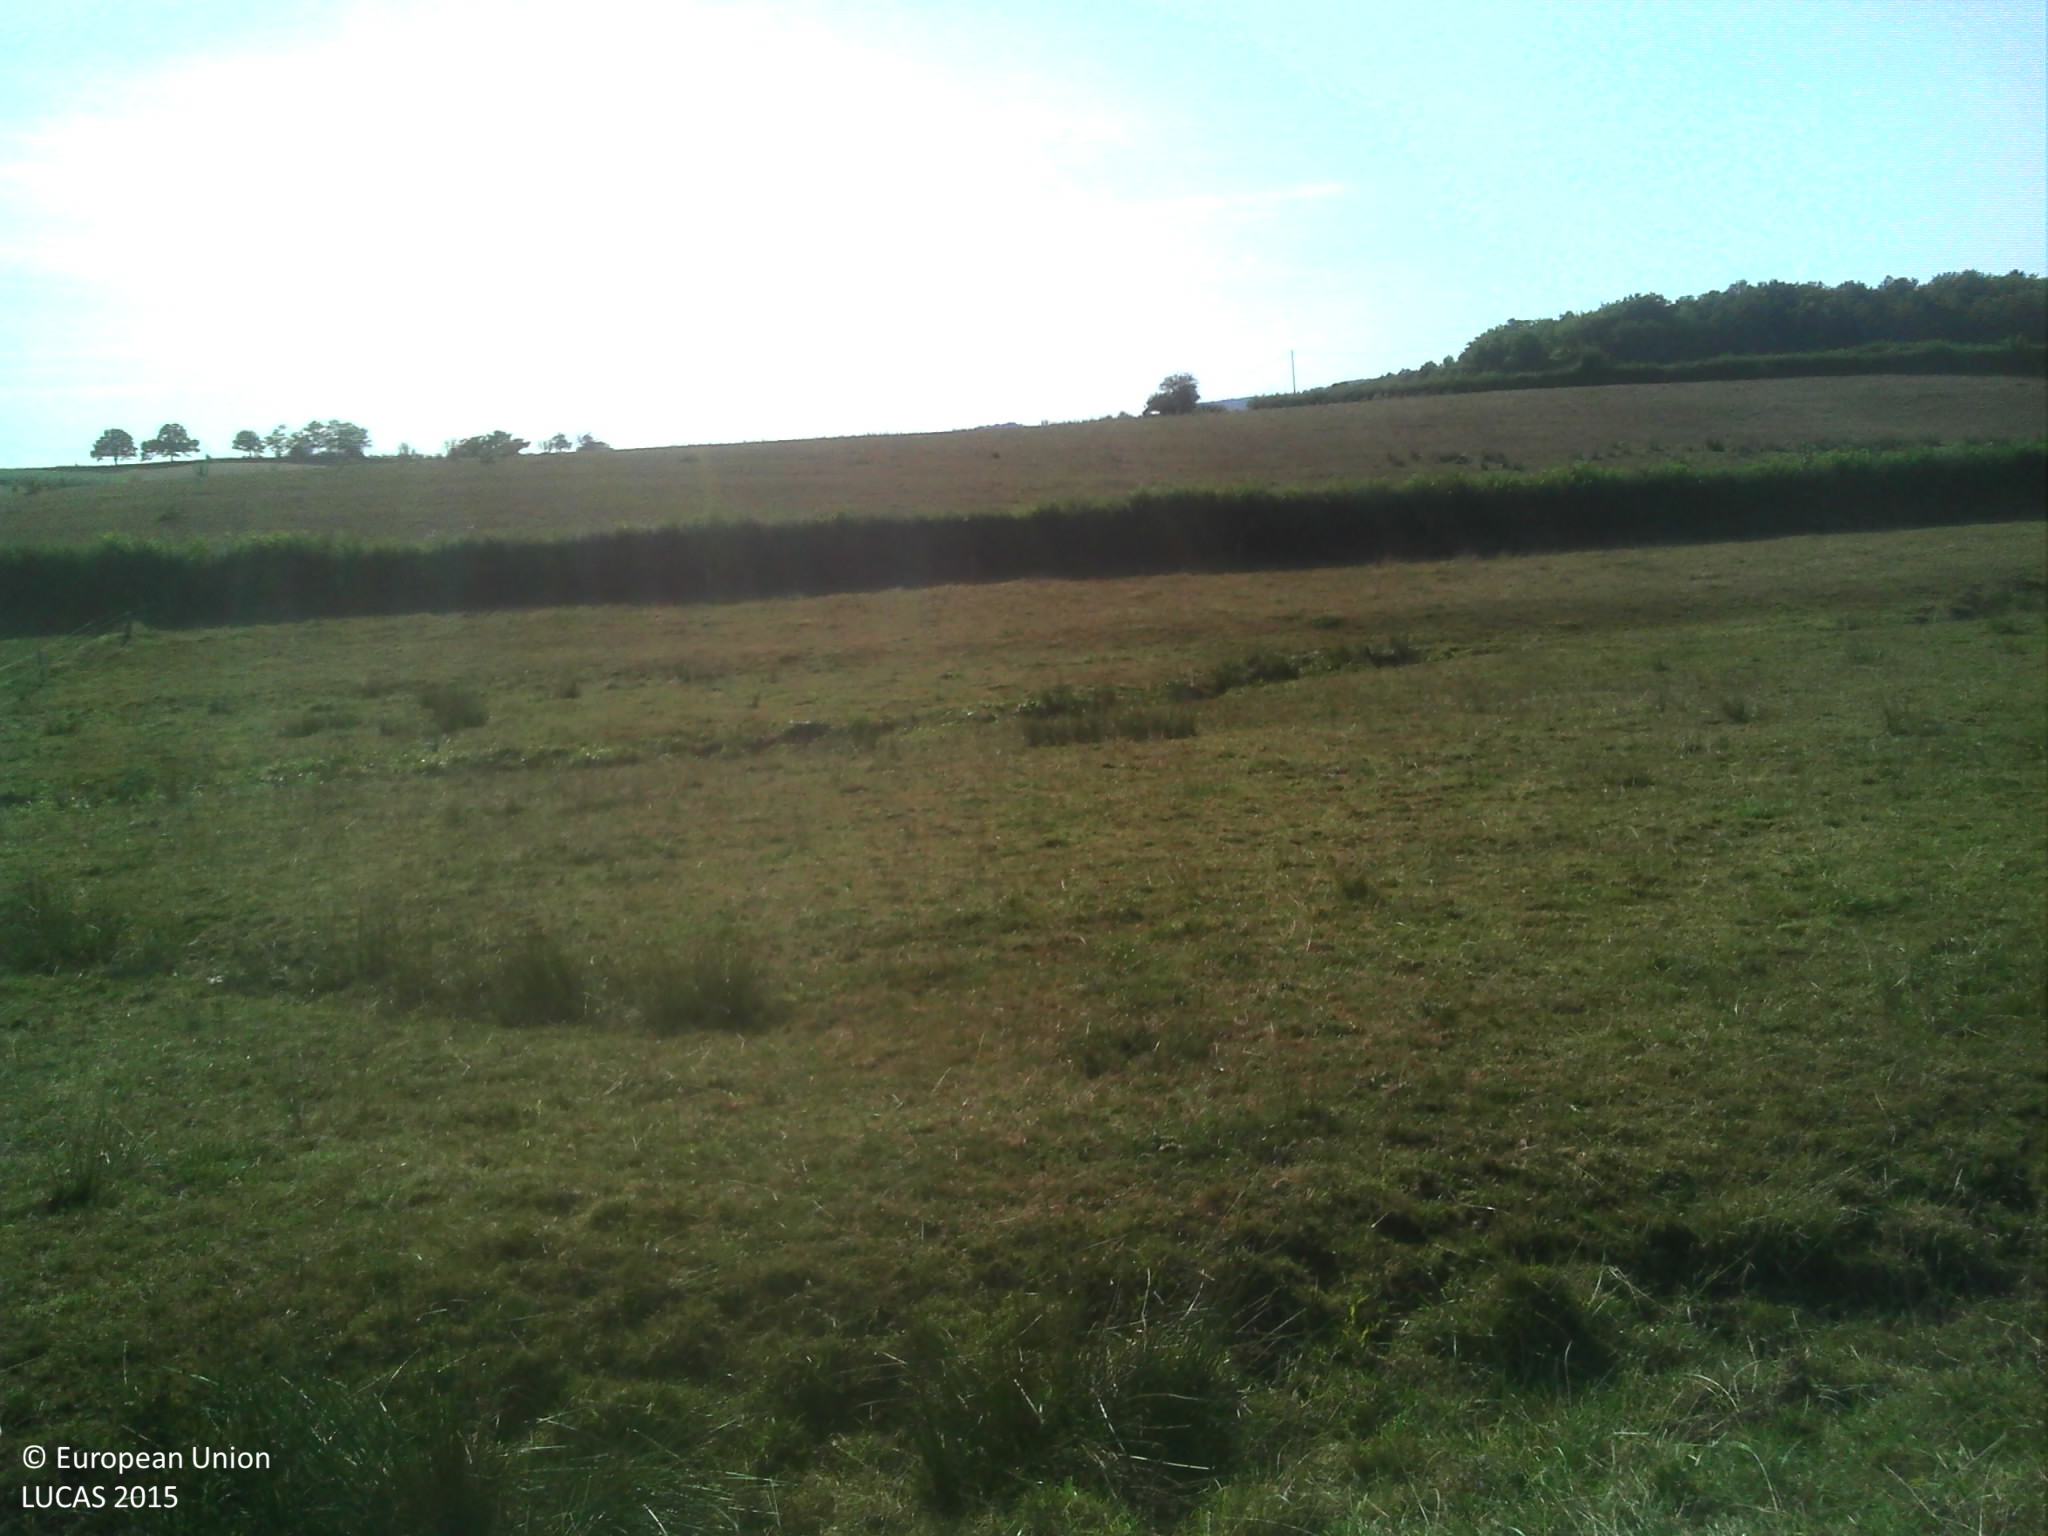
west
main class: Grassland
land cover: Grassland without tree/shrub cover
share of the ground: > 75 %
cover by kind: herbaceous plants 100 %
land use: Agriculture (excluding fallow land and kitchen gardens)
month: August
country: FR
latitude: 46.7798
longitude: 4.3553
